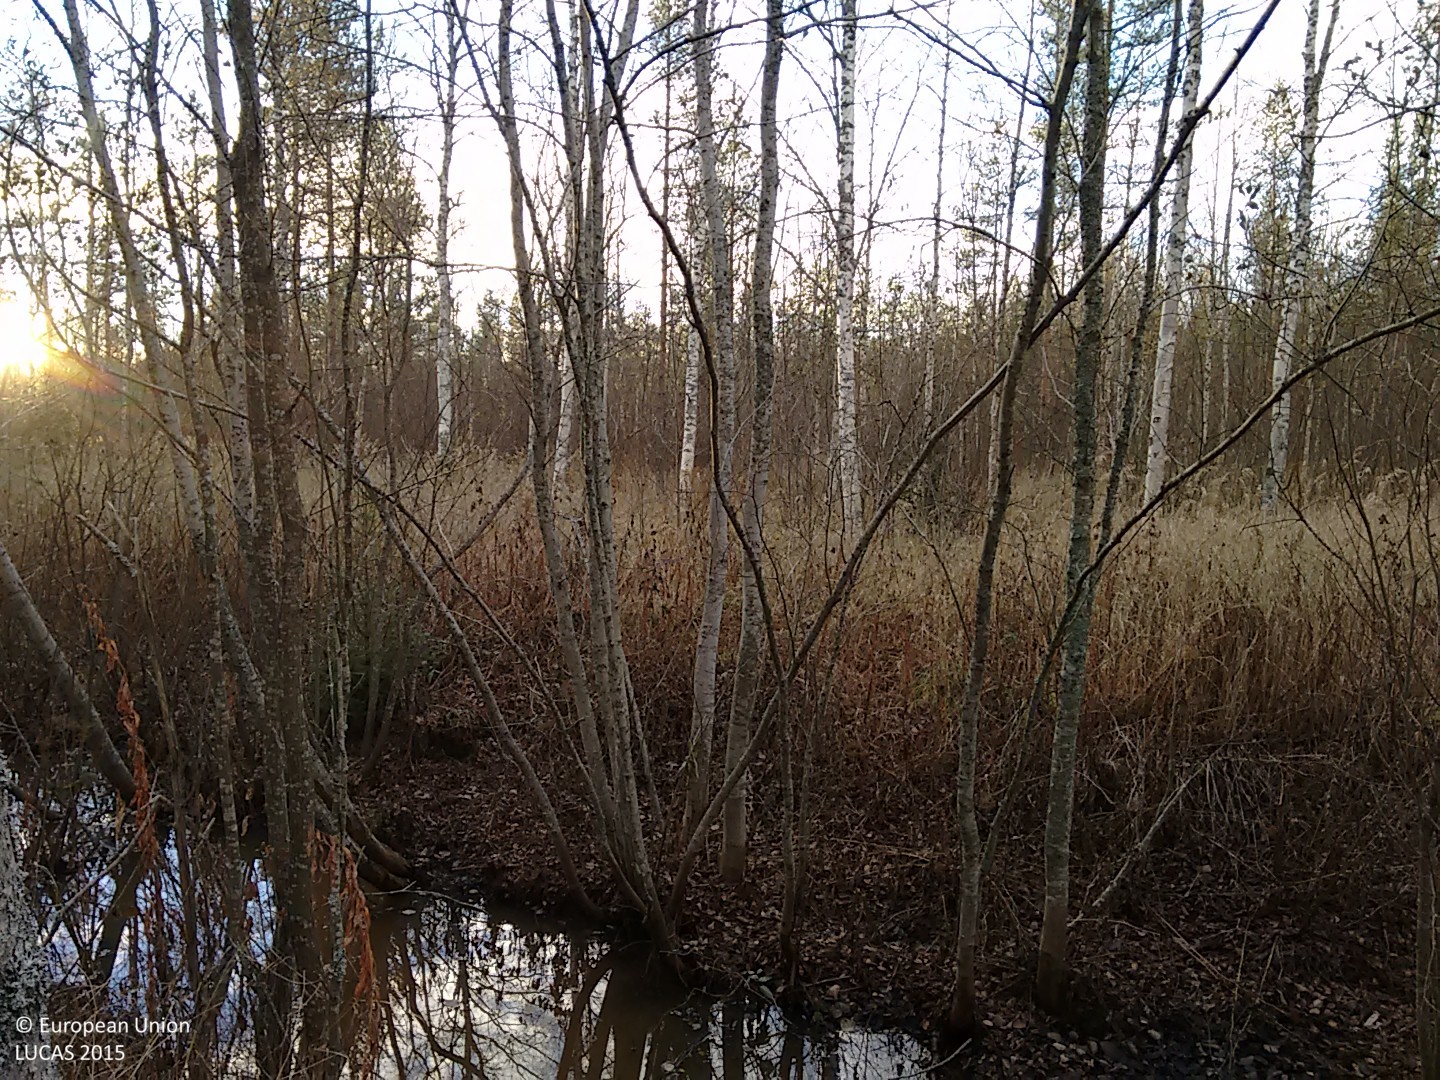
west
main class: Woodland
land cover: Broadleaved woodland
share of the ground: > 75 %
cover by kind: broadleaved forest trees 70 %, coniferous forest trees 10 %, shrubs 10 %, herbaceous plants 10 %
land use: Forestry
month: October
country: FI
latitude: 64.6601
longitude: 24.5810
